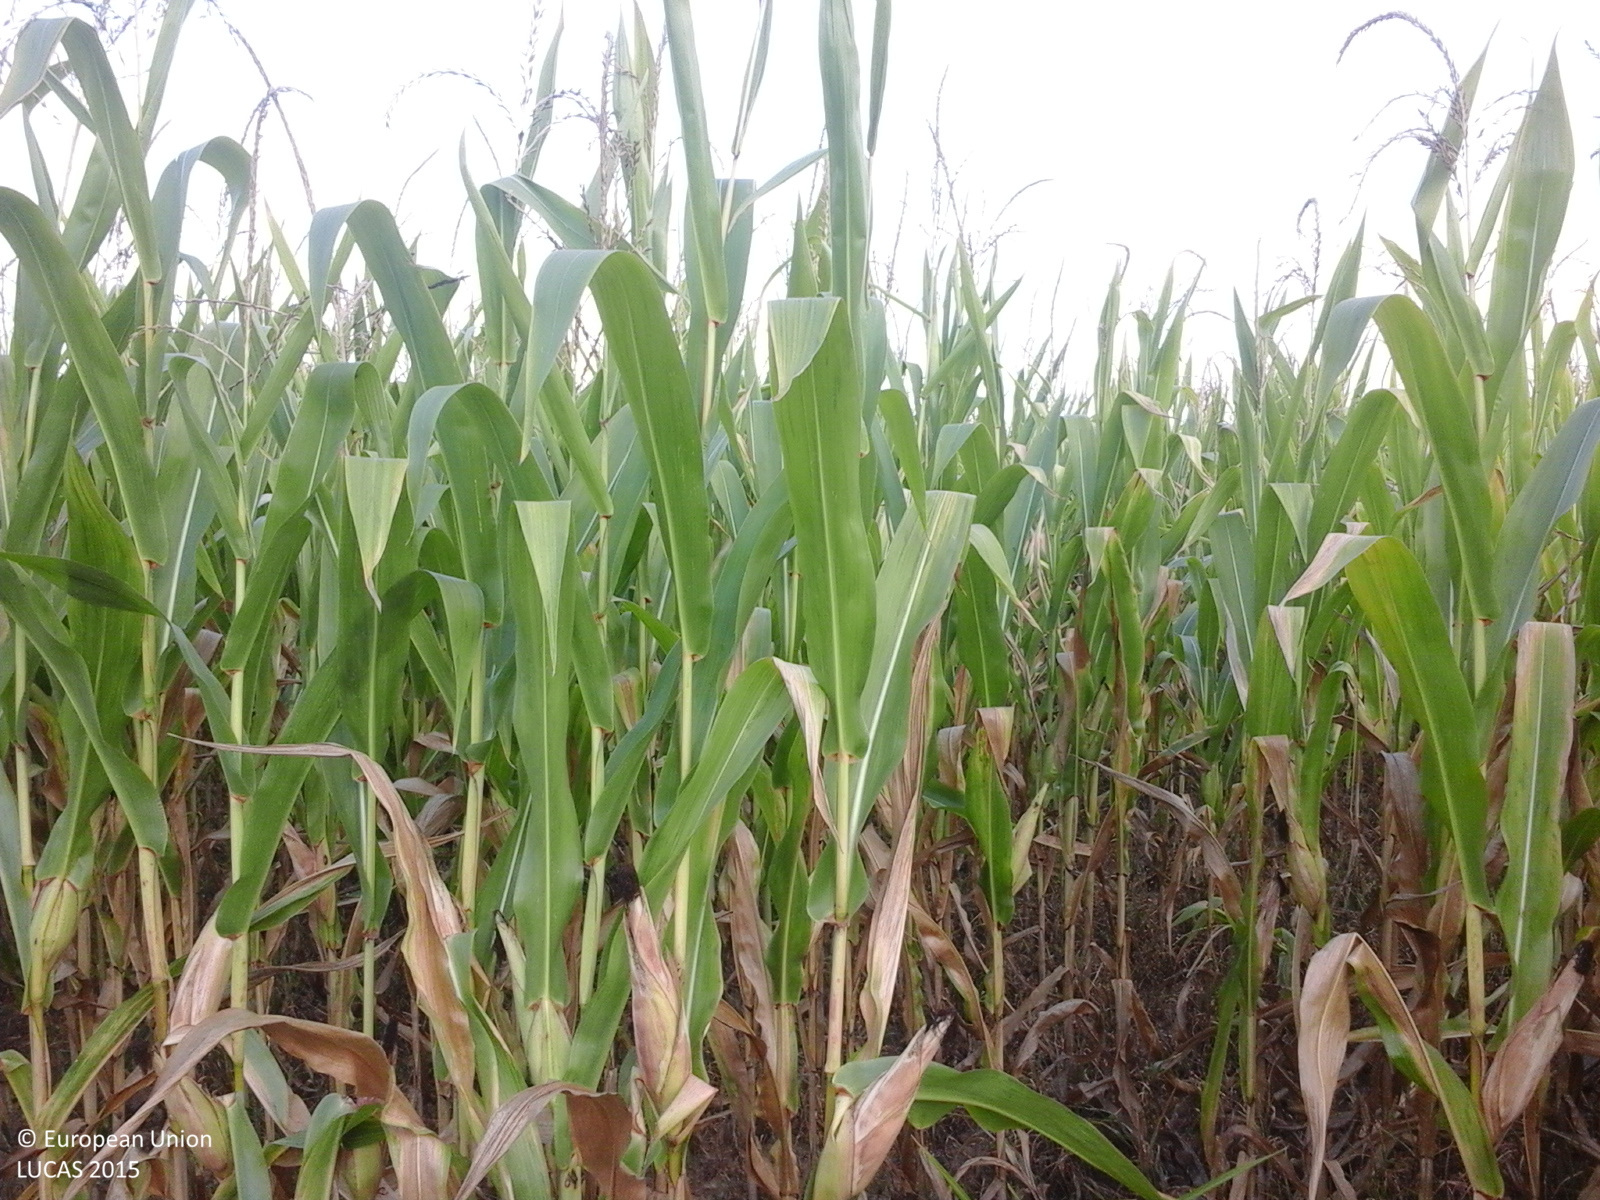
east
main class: Cropland
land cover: Maize
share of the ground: > 75 %
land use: Agriculture (excluding fallow land and kitchen gardens)
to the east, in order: Maize; Grass margins; Tracks; Grass margins; Common wheat; Maize; Spontaneously vegetated surfaces; Shrubland with sparse tree cover; Electric lines; Shrubland with sparse tree cover
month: September
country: RO
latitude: 47.6626
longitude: 23.3483
